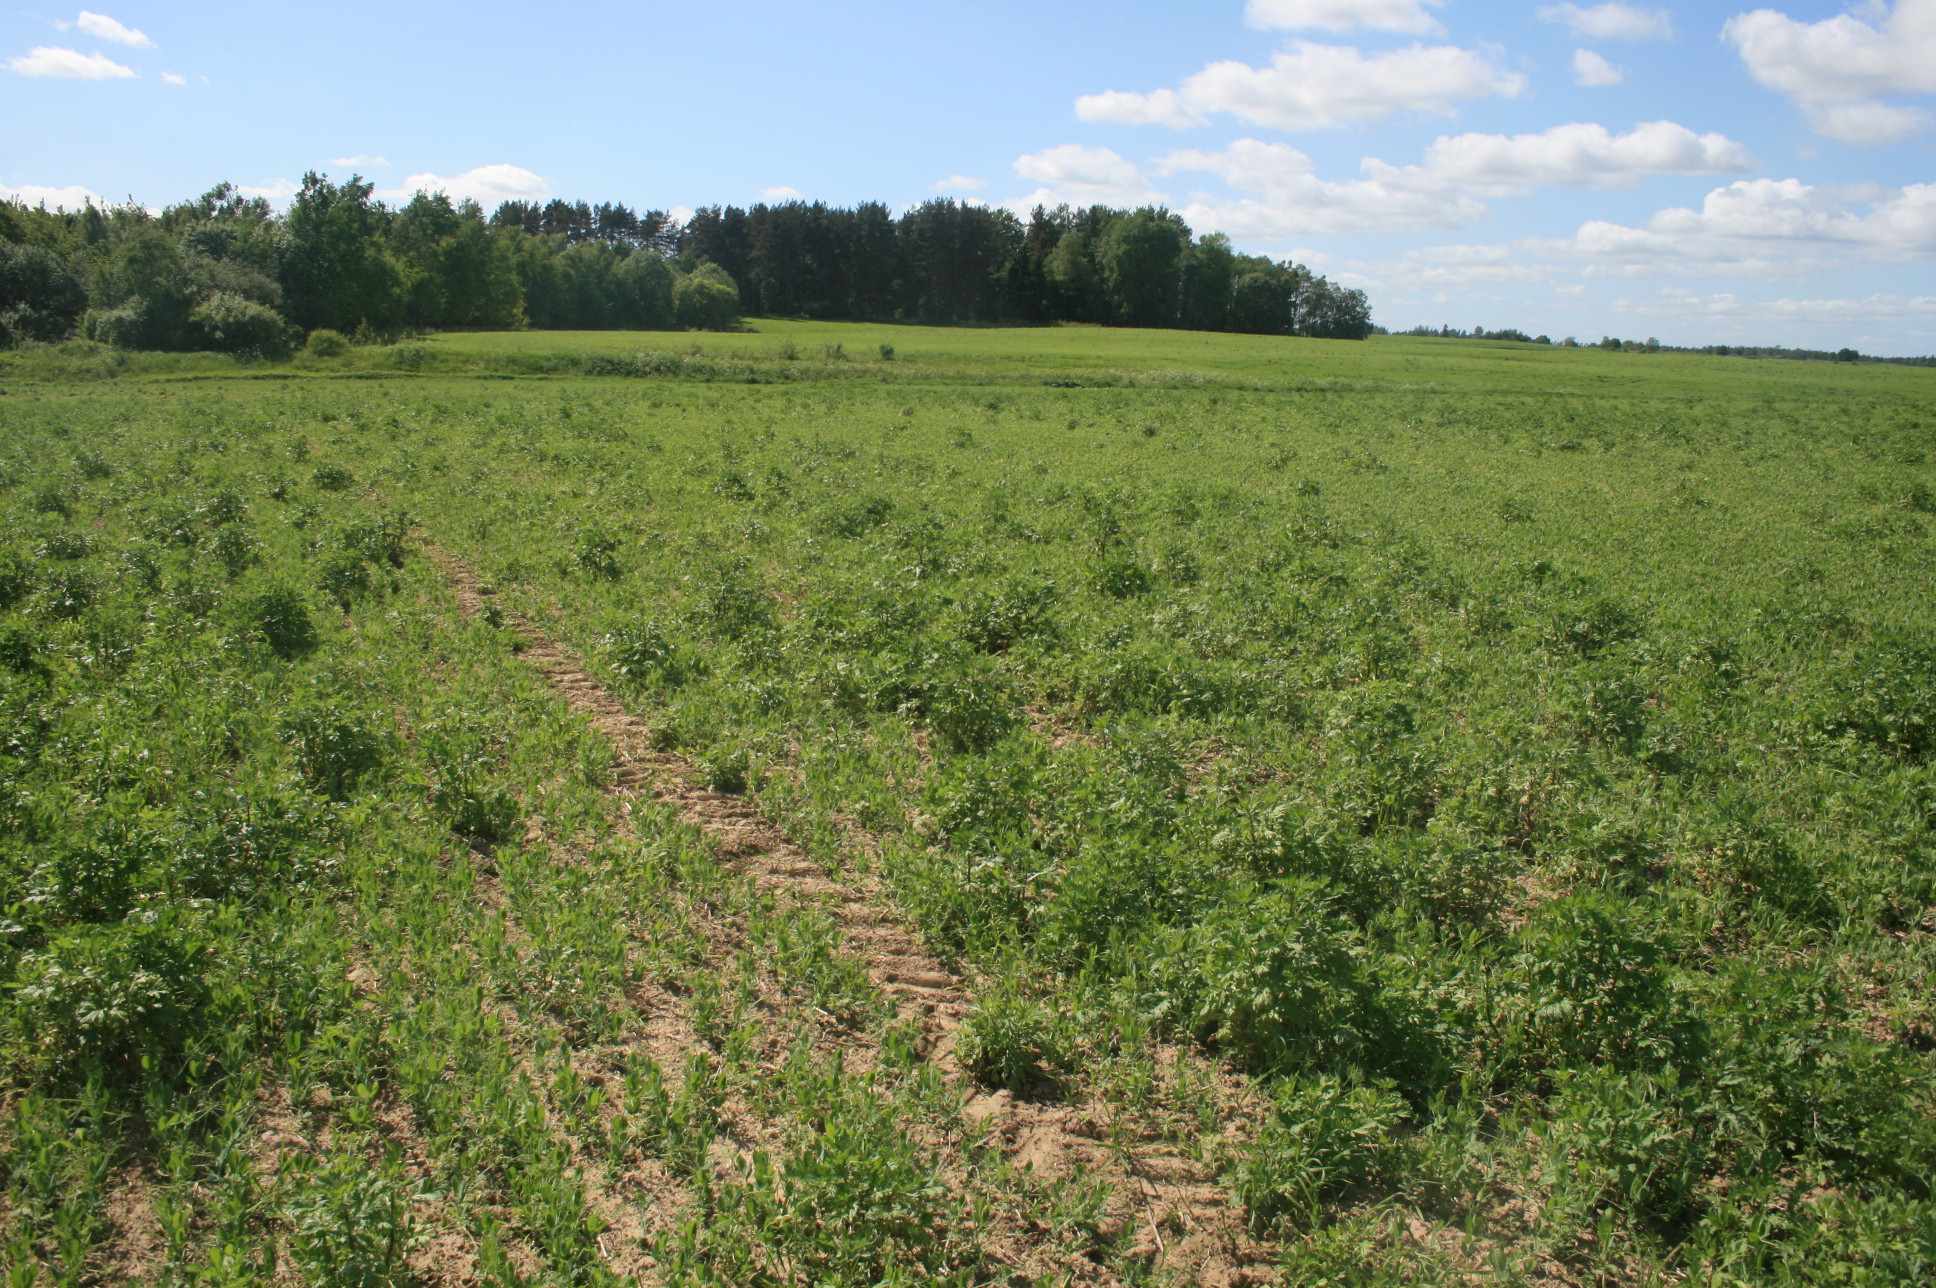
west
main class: Cropland
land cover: Dry pulses
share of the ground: > 75 %
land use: Agriculture (excluding fallow land and kitchen gardens)
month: June
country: LT
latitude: 56.0595
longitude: 22.3746
